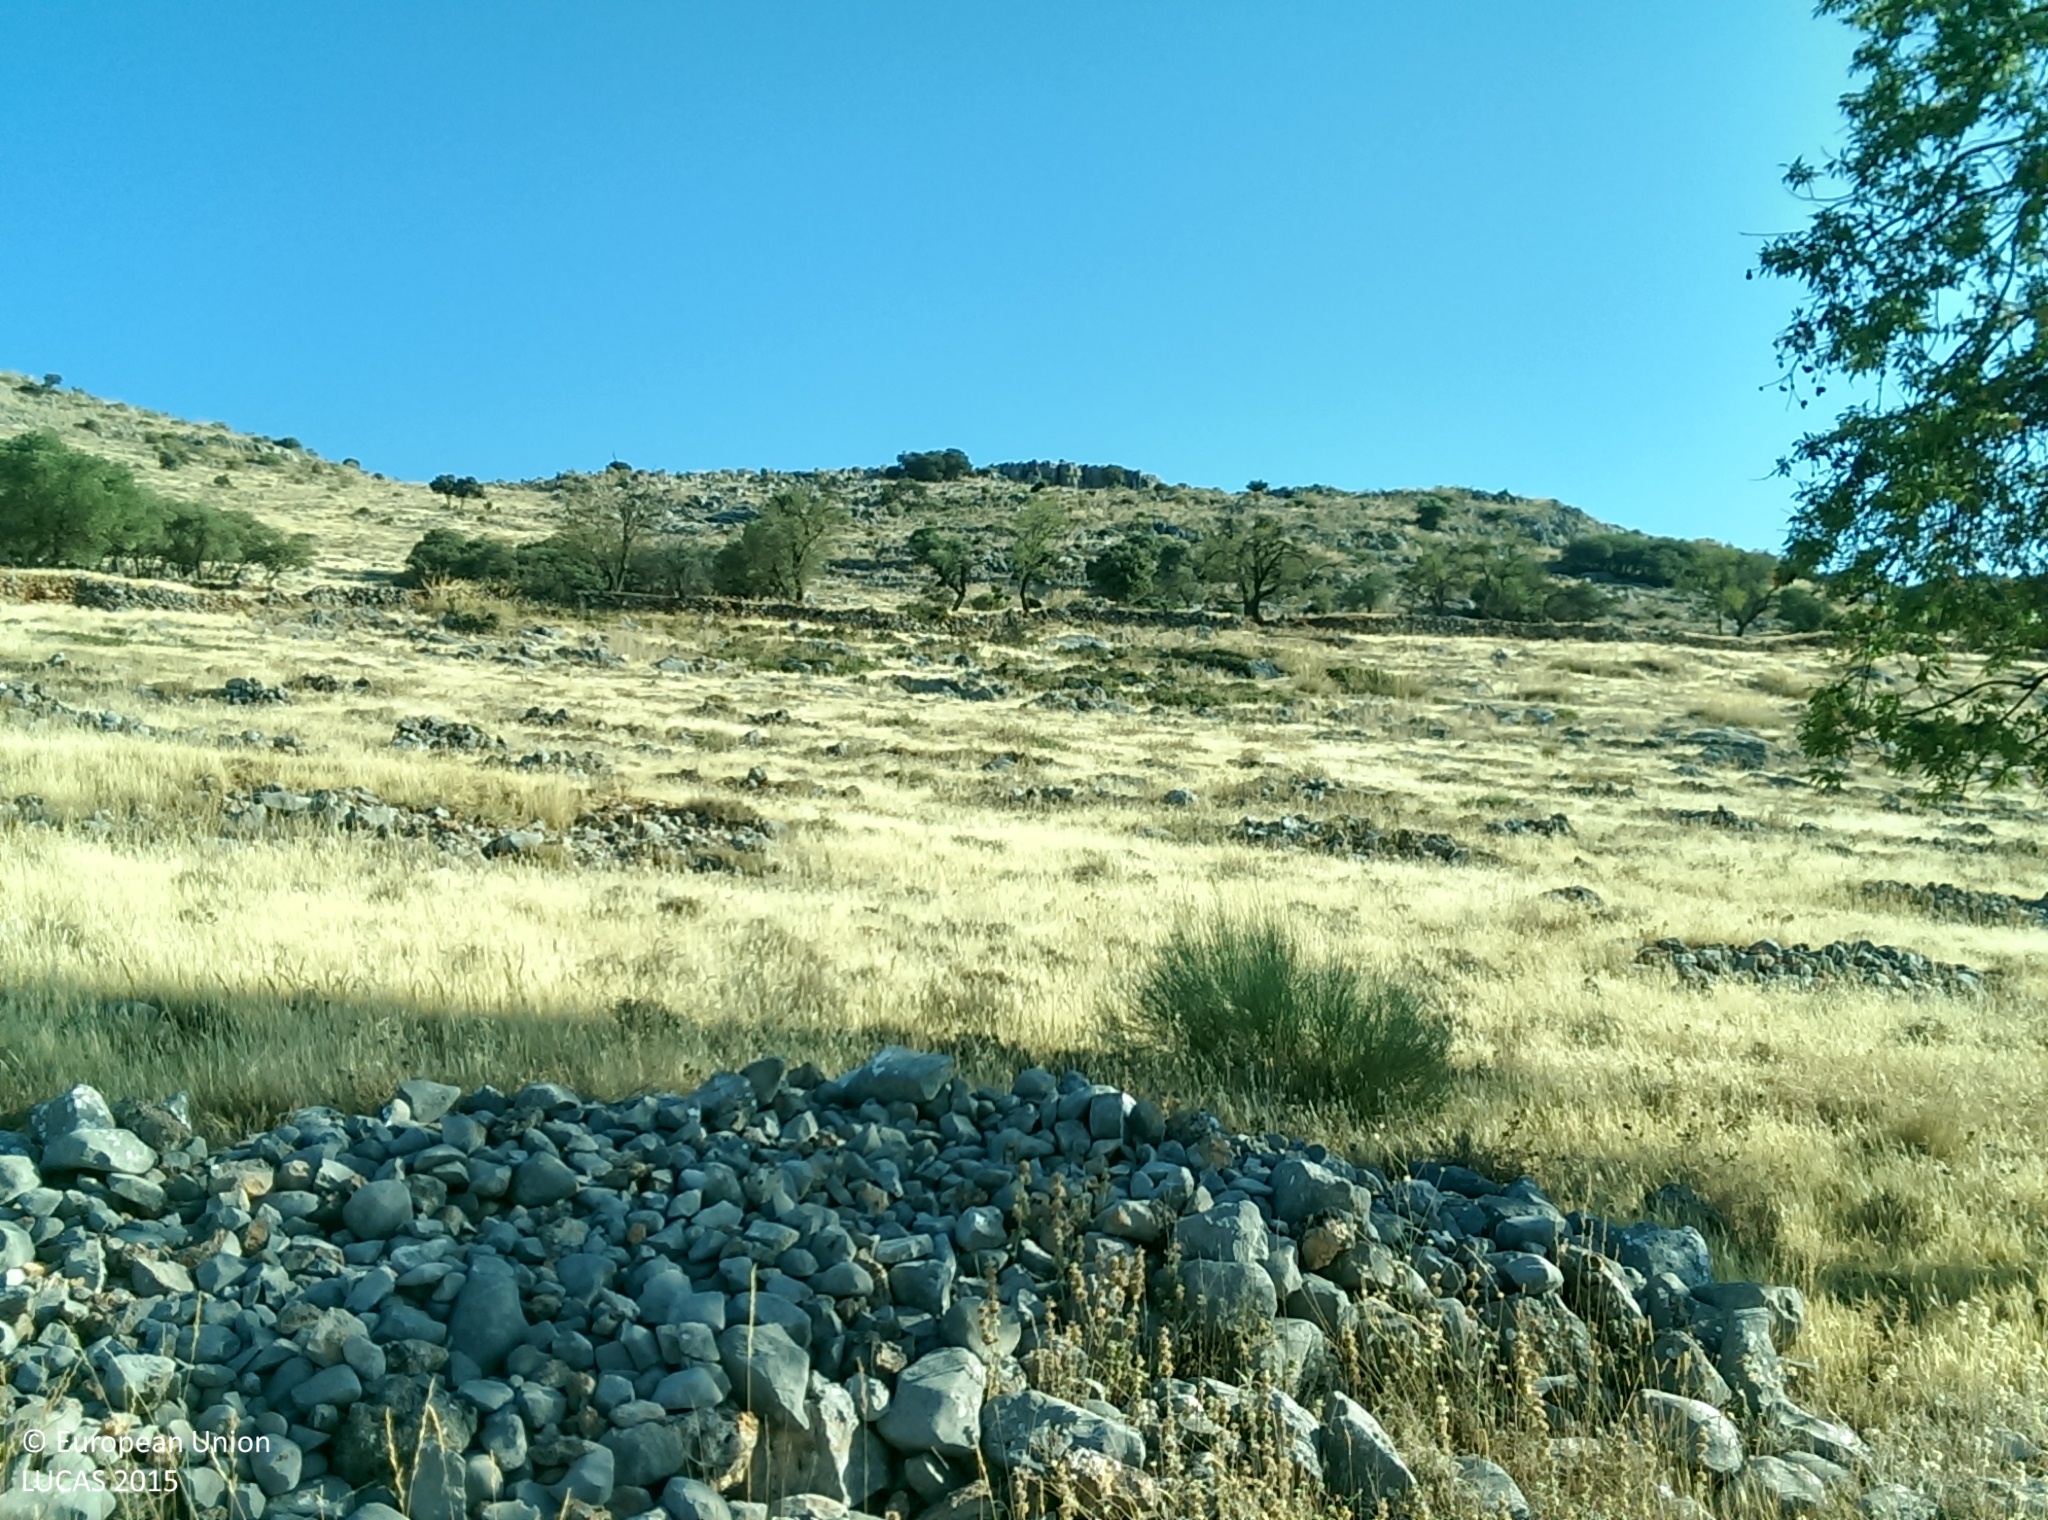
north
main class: Grassland
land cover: Grassland without tree/shrub cover
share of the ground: > 75 %
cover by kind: herbaceous plants 100 %
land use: Agriculture (excluding fallow land and kitchen gardens)
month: July
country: ES
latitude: 37.3765
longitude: -3.6917
